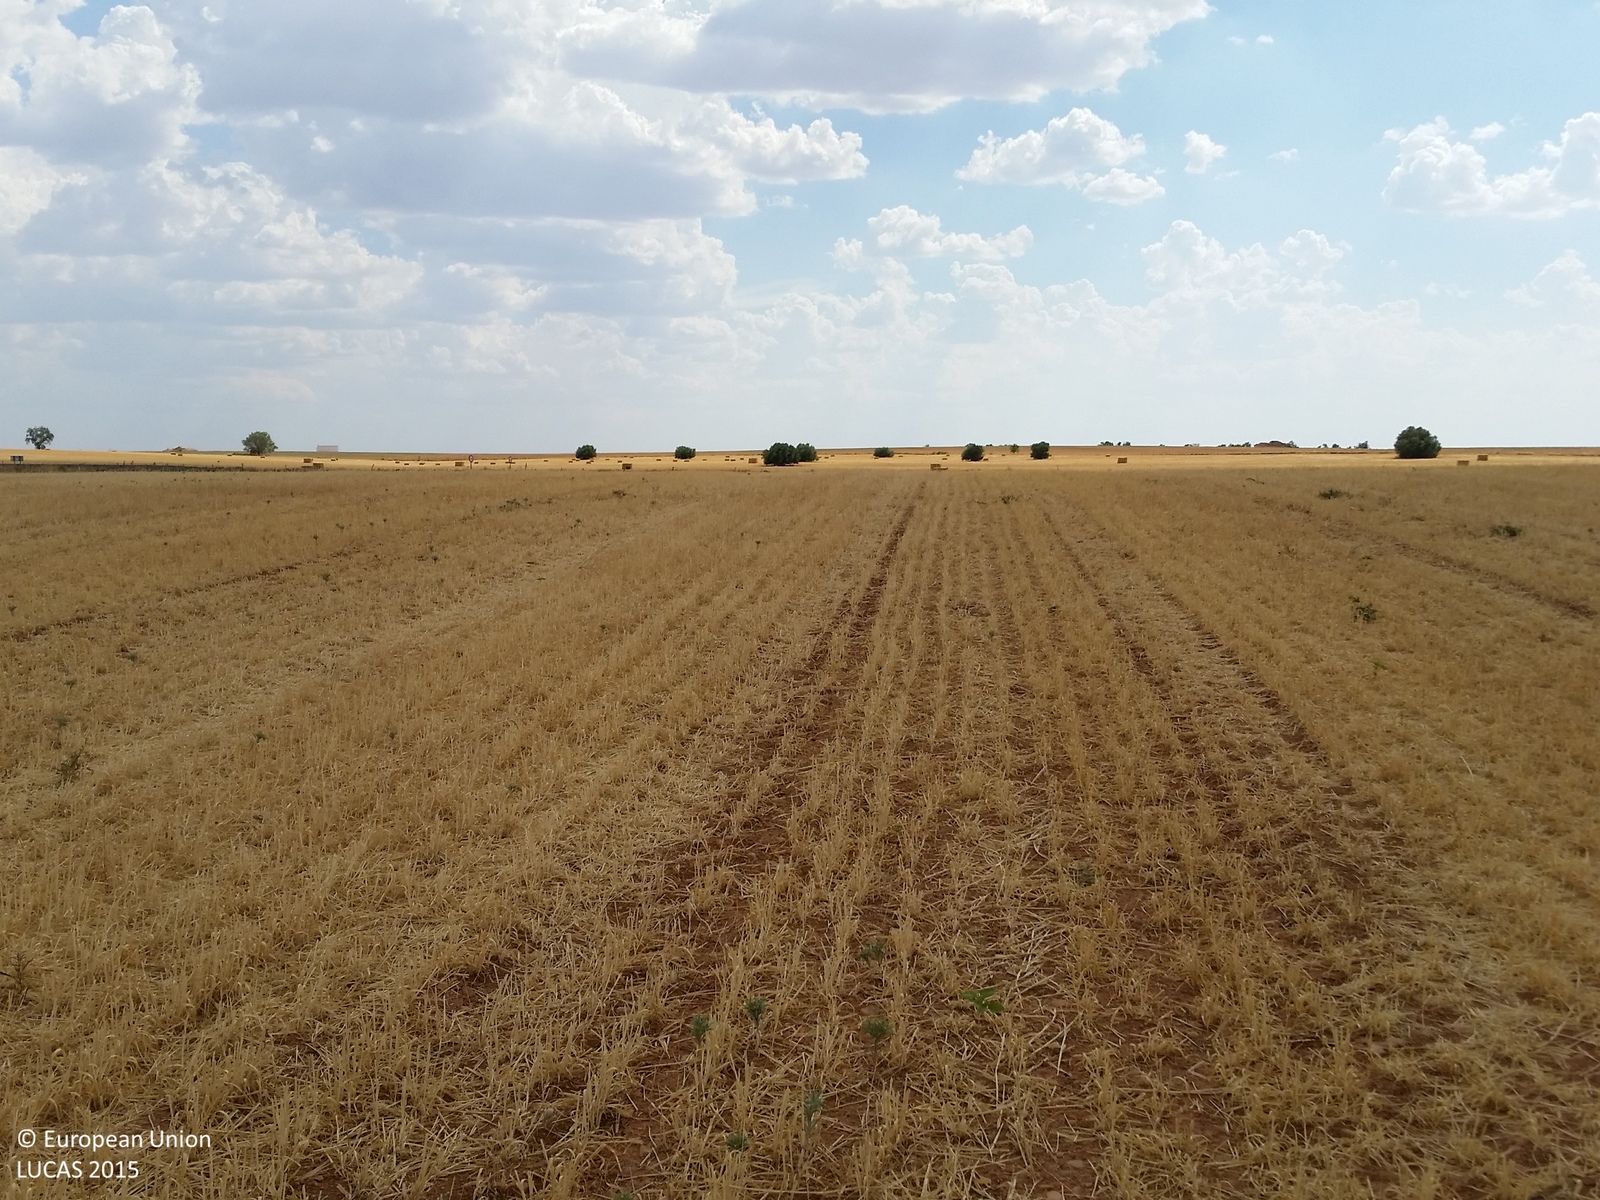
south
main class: Cropland
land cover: Barley
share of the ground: < 10 %
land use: Agriculture (excluding fallow land and kitchen gardens)
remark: Harvested field
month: July
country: ES
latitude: 39.1840
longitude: -2.6863
